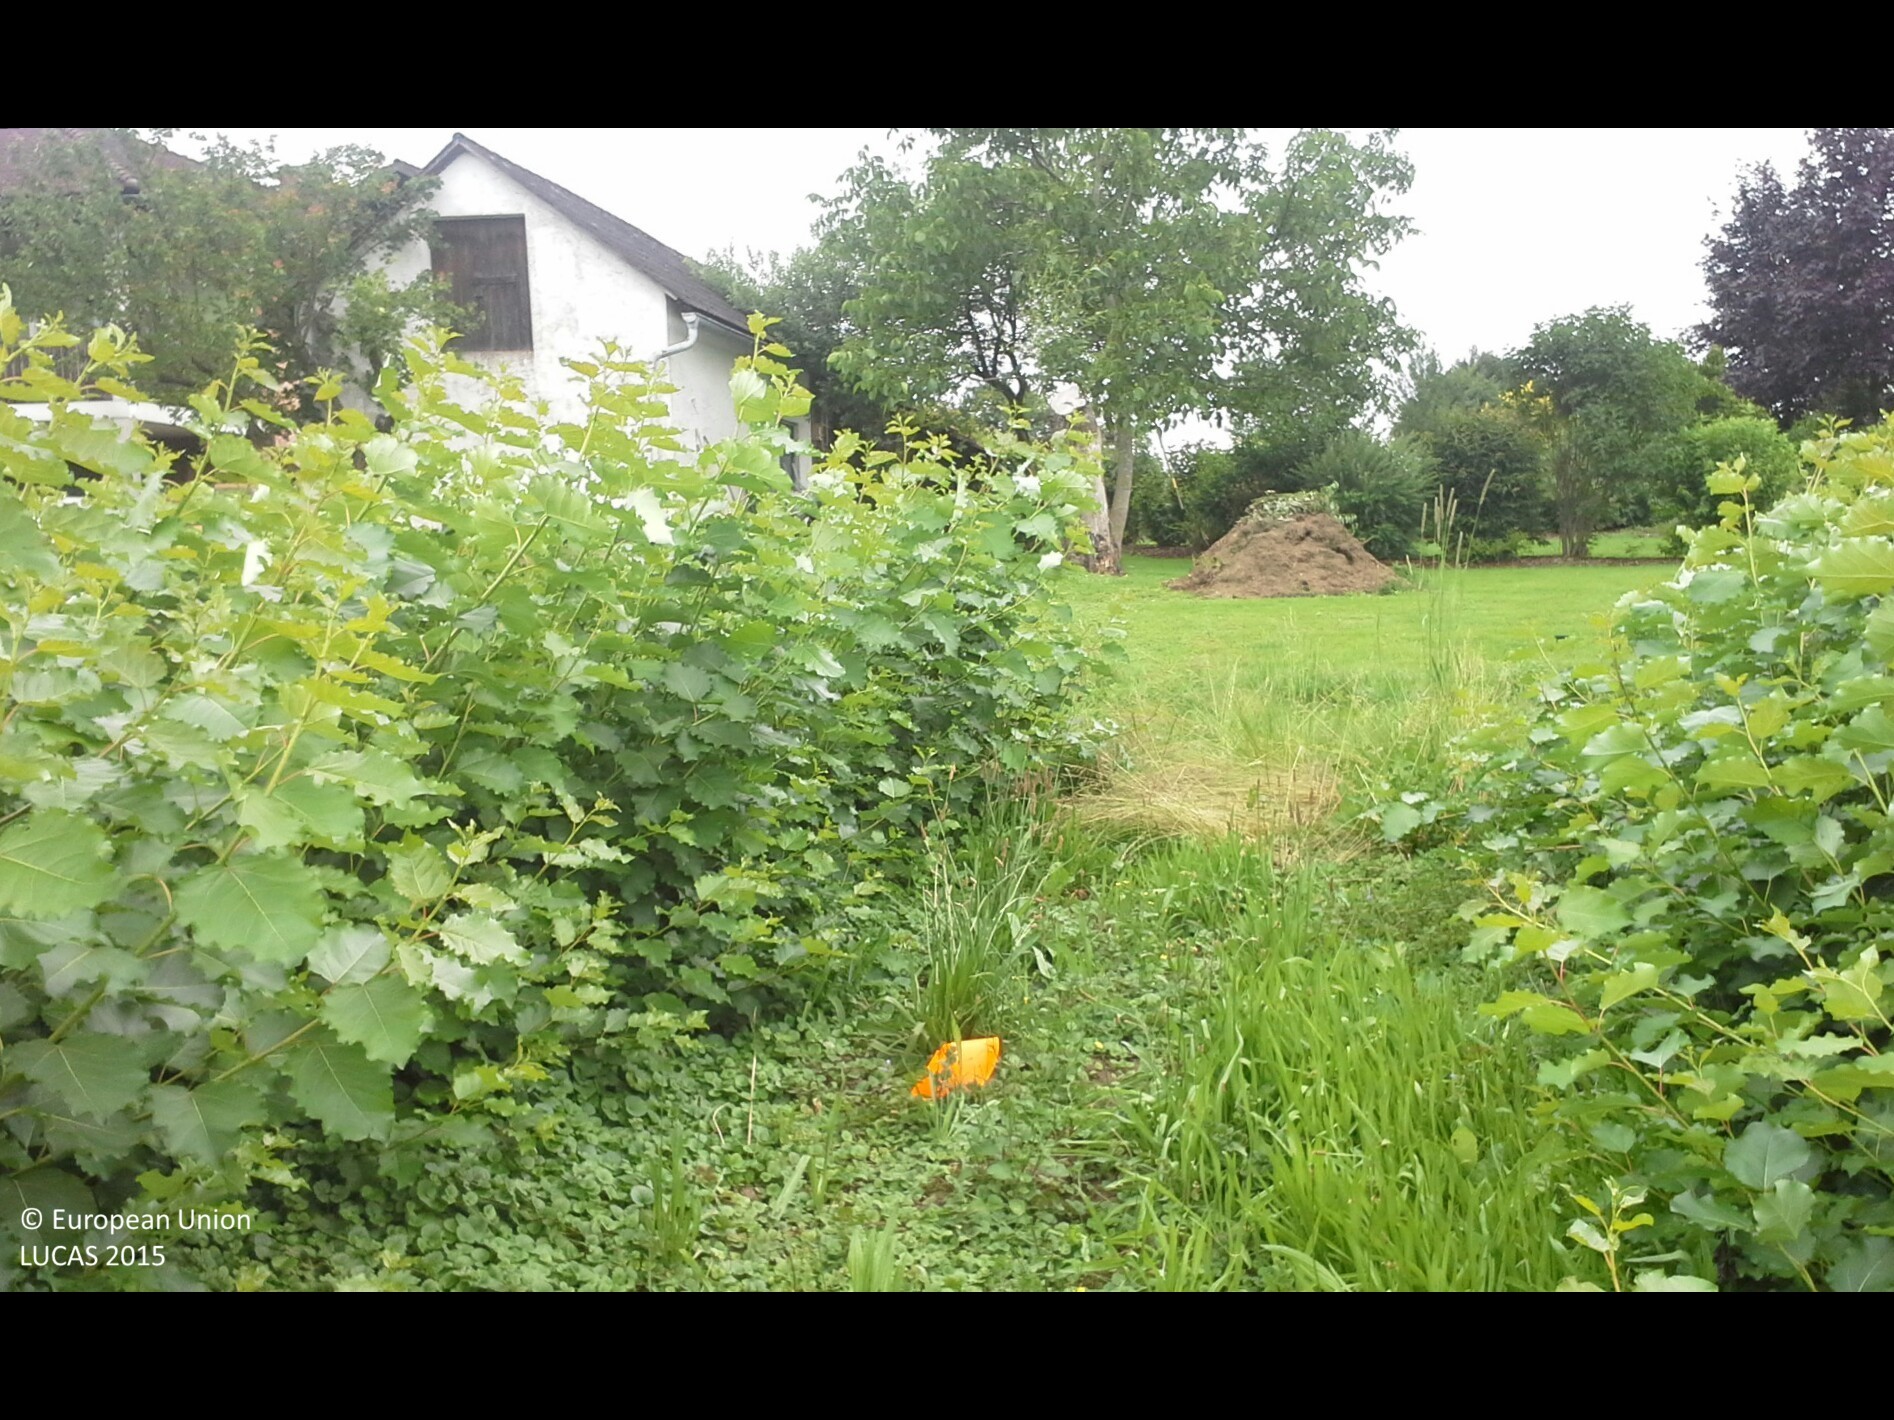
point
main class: Cropland
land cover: Other fruit trees and berries
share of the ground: 50 - 75 %
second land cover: Spontaneously vegetated surfaces
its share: 25 - 50 %
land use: Agriculture (excluding fallow land and kitchen gardens)
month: June
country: AT
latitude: 48.1093
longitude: 14.6071
